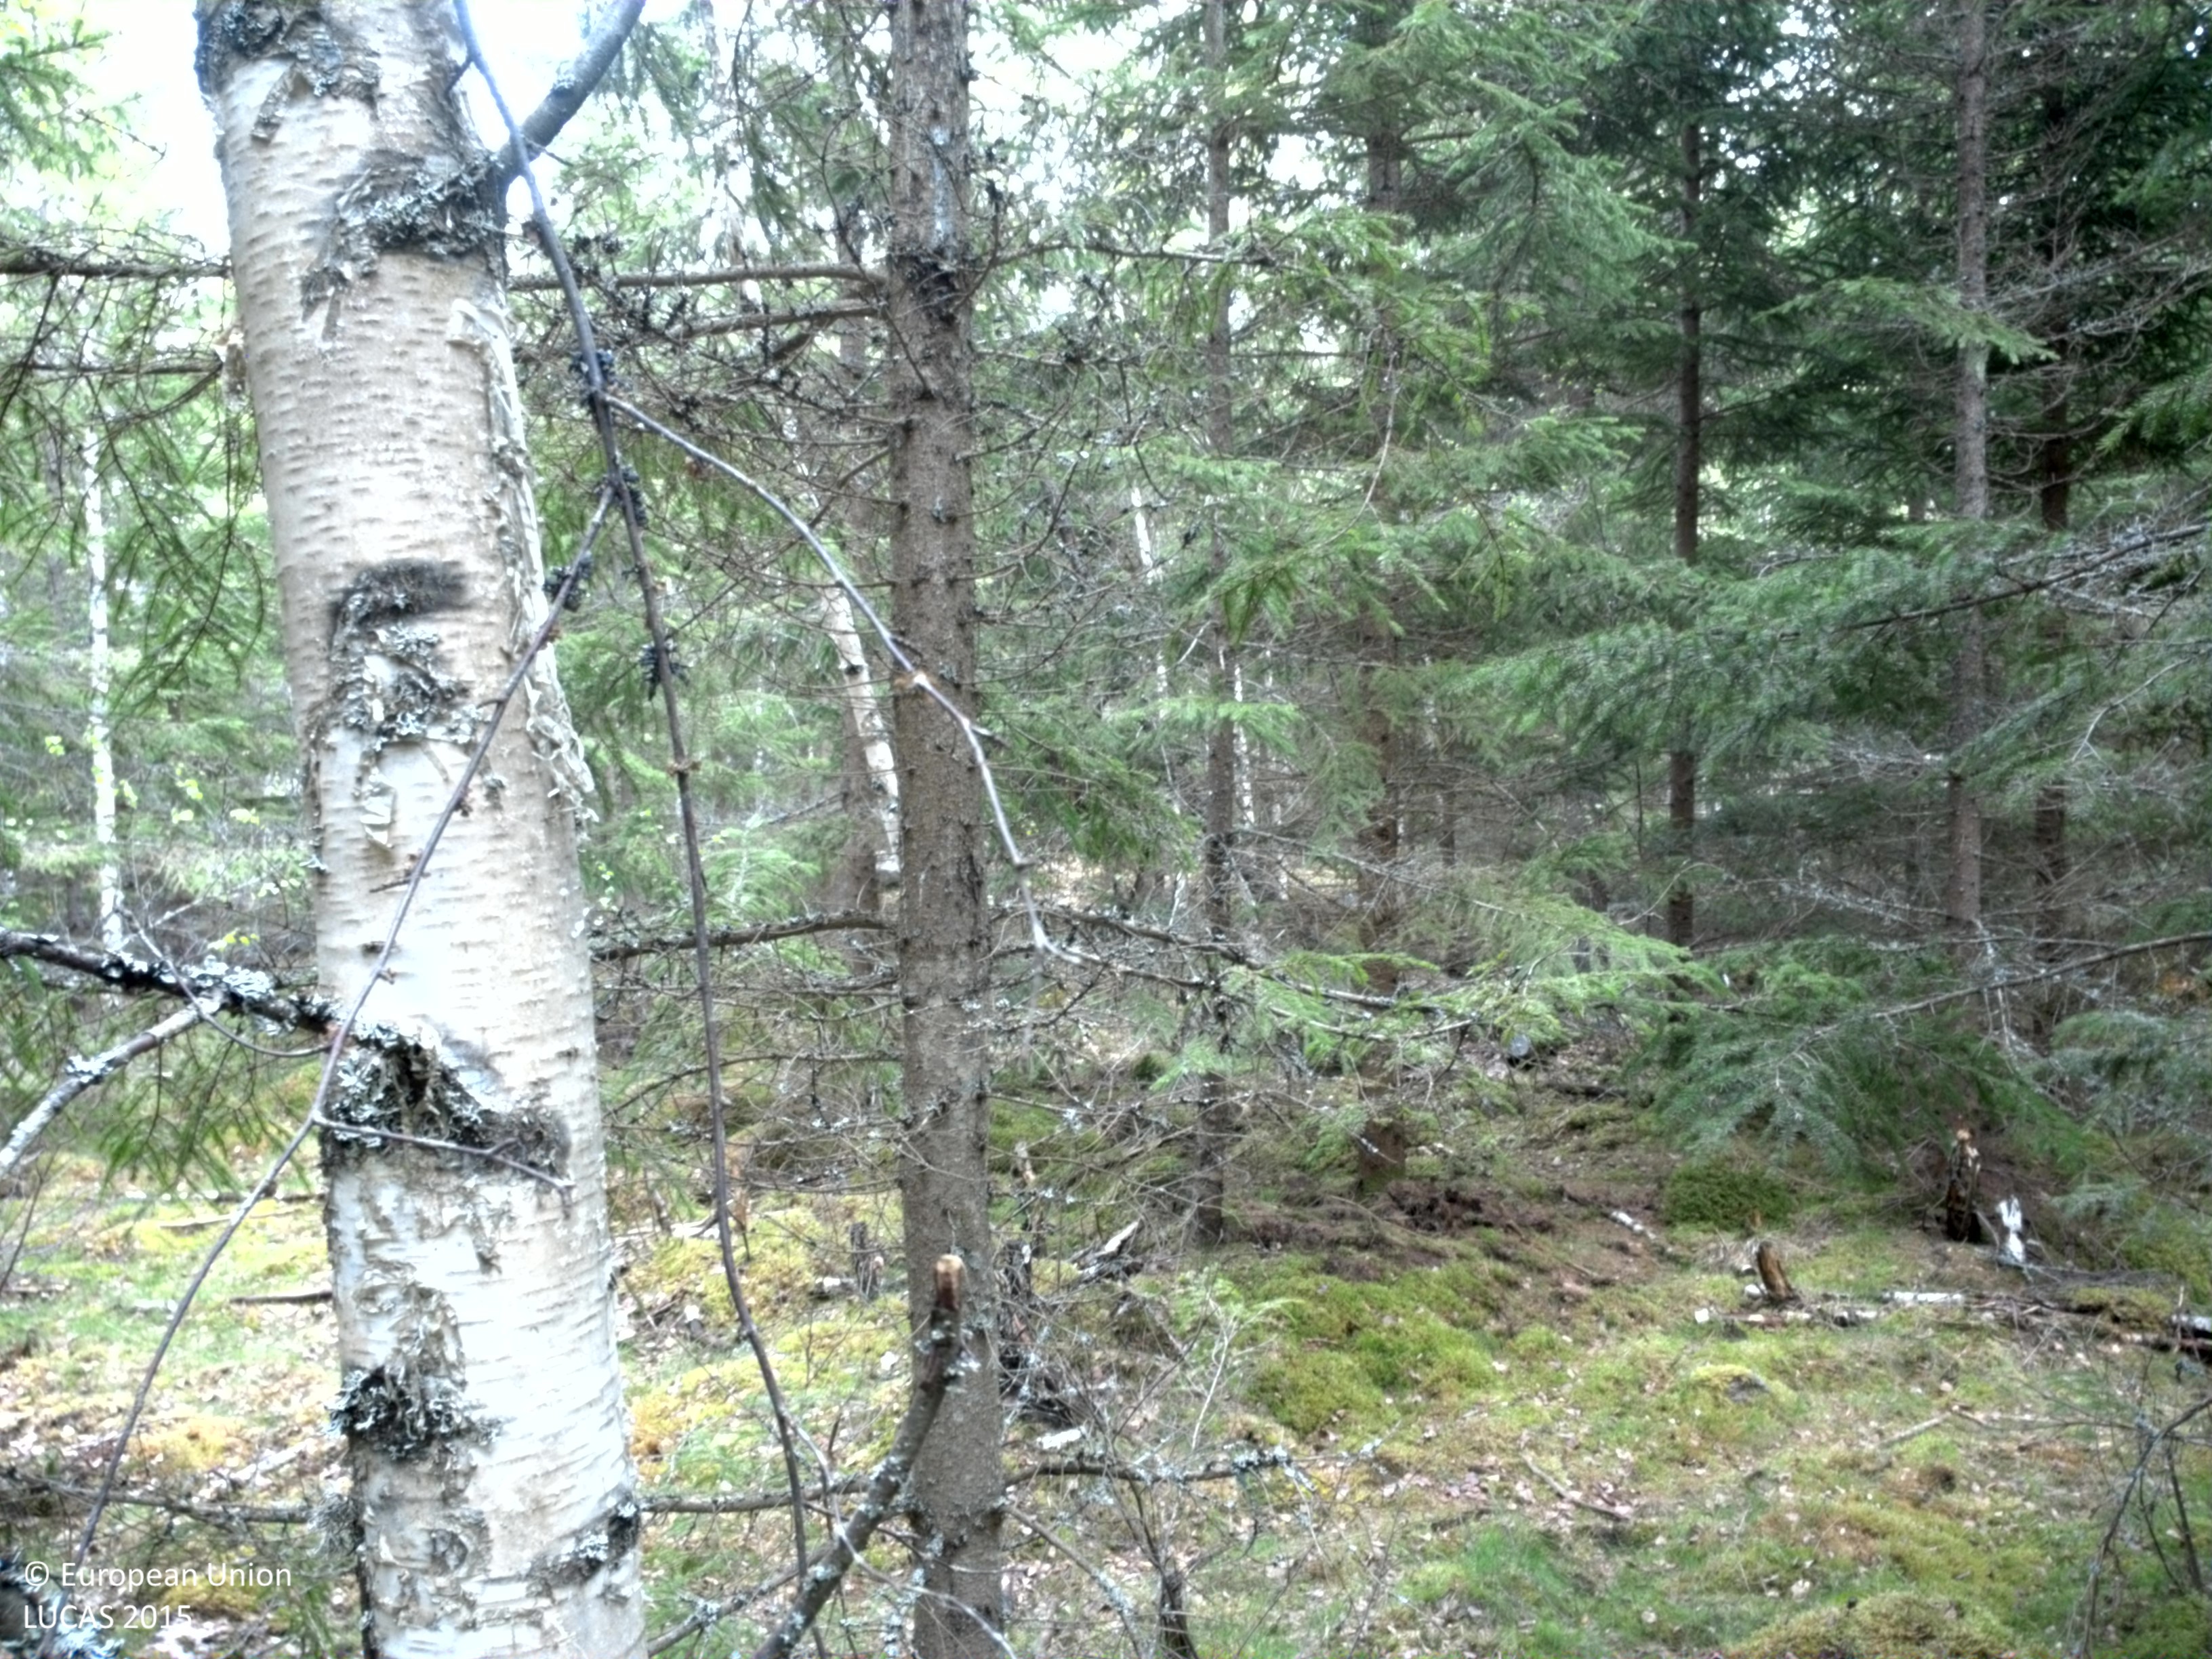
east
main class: Woodland
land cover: Spruce dominated mixed woodland
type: boreal forest
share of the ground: > 75 %
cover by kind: coniferous forest trees 40 %, broadleaved forest trees 40 %, lichens and mosses 20 %
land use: Forestry
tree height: > 5 m
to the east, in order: Spruce dominated mixed woodland; Pine dominated coniferous woodland; Inland marshes
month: May
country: SE
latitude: 56.7717
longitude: 15.0865
